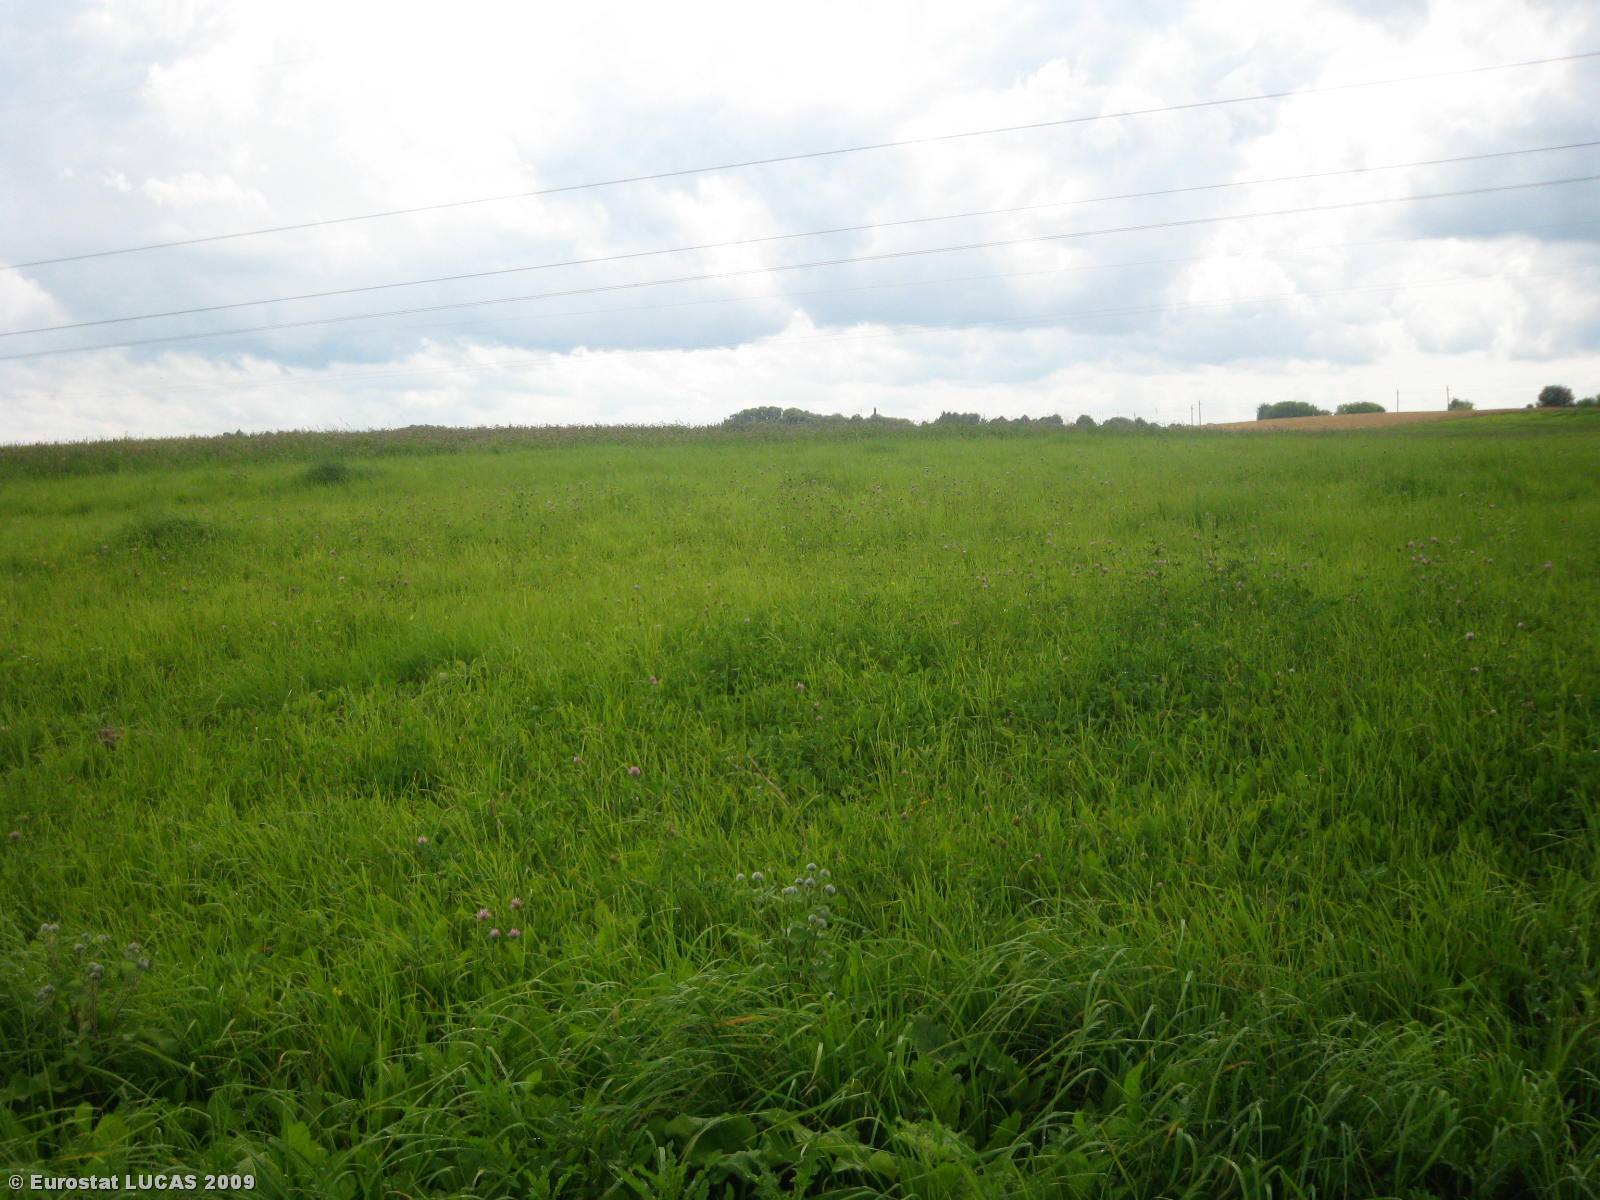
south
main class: Grassland
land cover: Grassland without tree/shrub cover
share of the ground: > 75 %
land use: Agriculture (excluding fallow land and kitchen gardens)
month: July
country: LT
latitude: 55.0615
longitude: 23.5623
